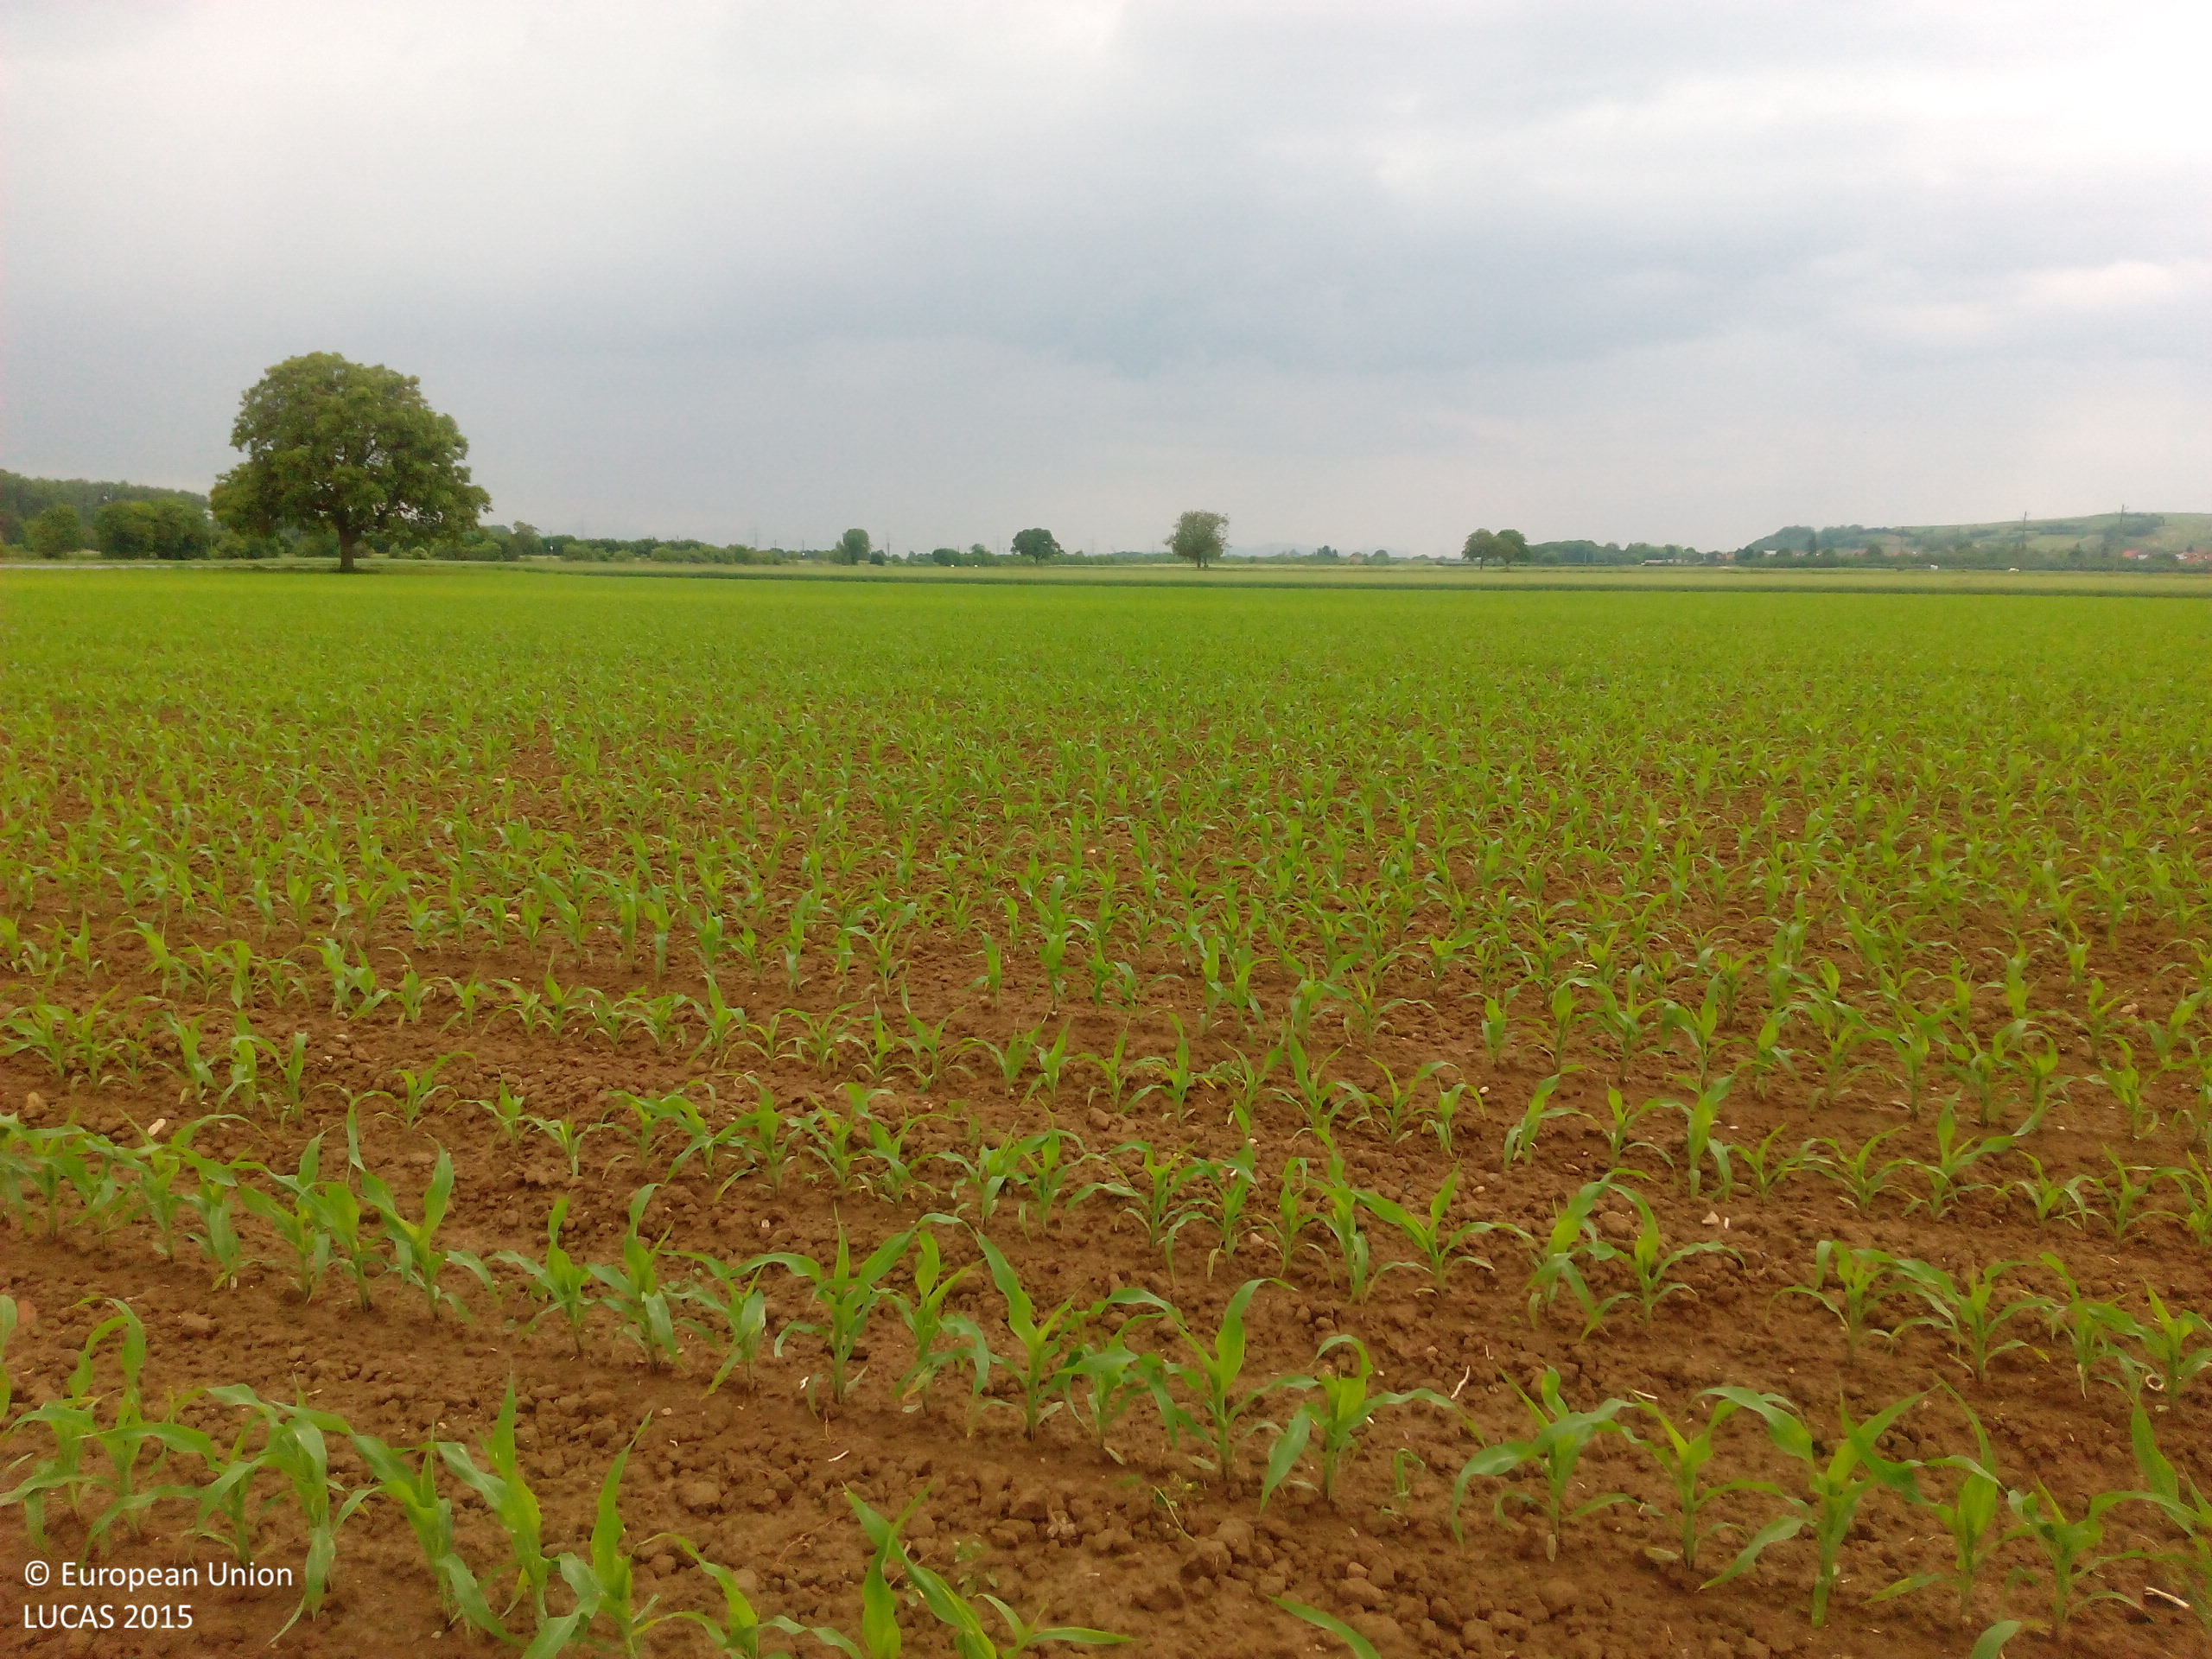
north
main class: Cropland
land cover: Maize
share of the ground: 25 - 50 %
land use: Agriculture (excluding fallow land and kitchen gardens)
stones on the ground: < 10 %
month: May
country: DE
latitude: 47.8196
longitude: 7.6106
